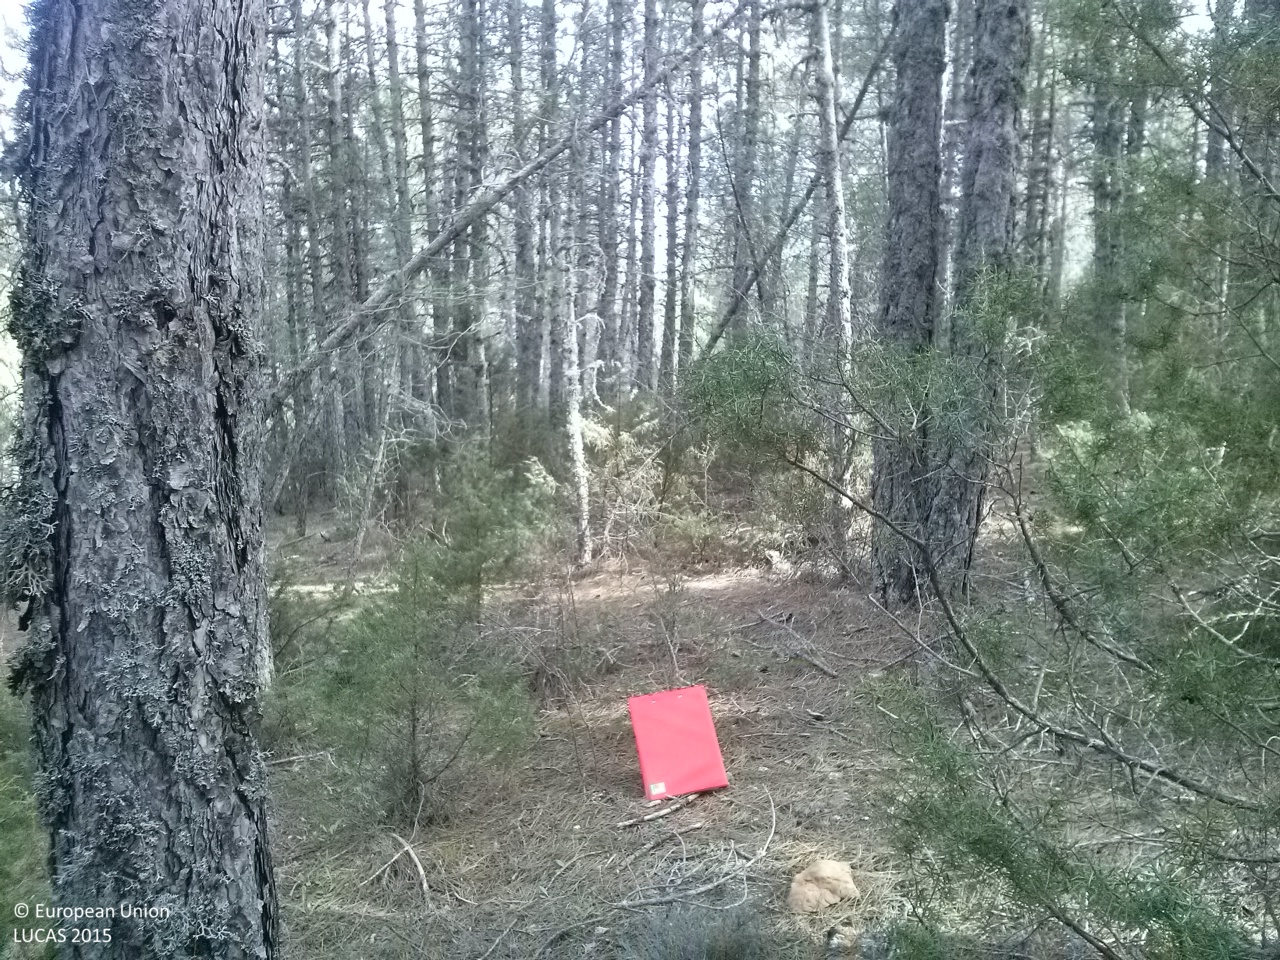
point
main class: Woodland
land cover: Pine dominated coniferous woodland
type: coniferous forest of the mediterranean region
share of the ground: > 75 %
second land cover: Grassland without tree/shrub cover
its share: 10 - 25 %
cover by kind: coniferous forest trees 85 %, herbaceous plants 10 %, shrubs 5 %
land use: Forestry
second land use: Agriculture (excluding fallow land and kitchen gardens)
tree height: > 5 m
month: April
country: ES
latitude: 40.1190
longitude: -1.9478
